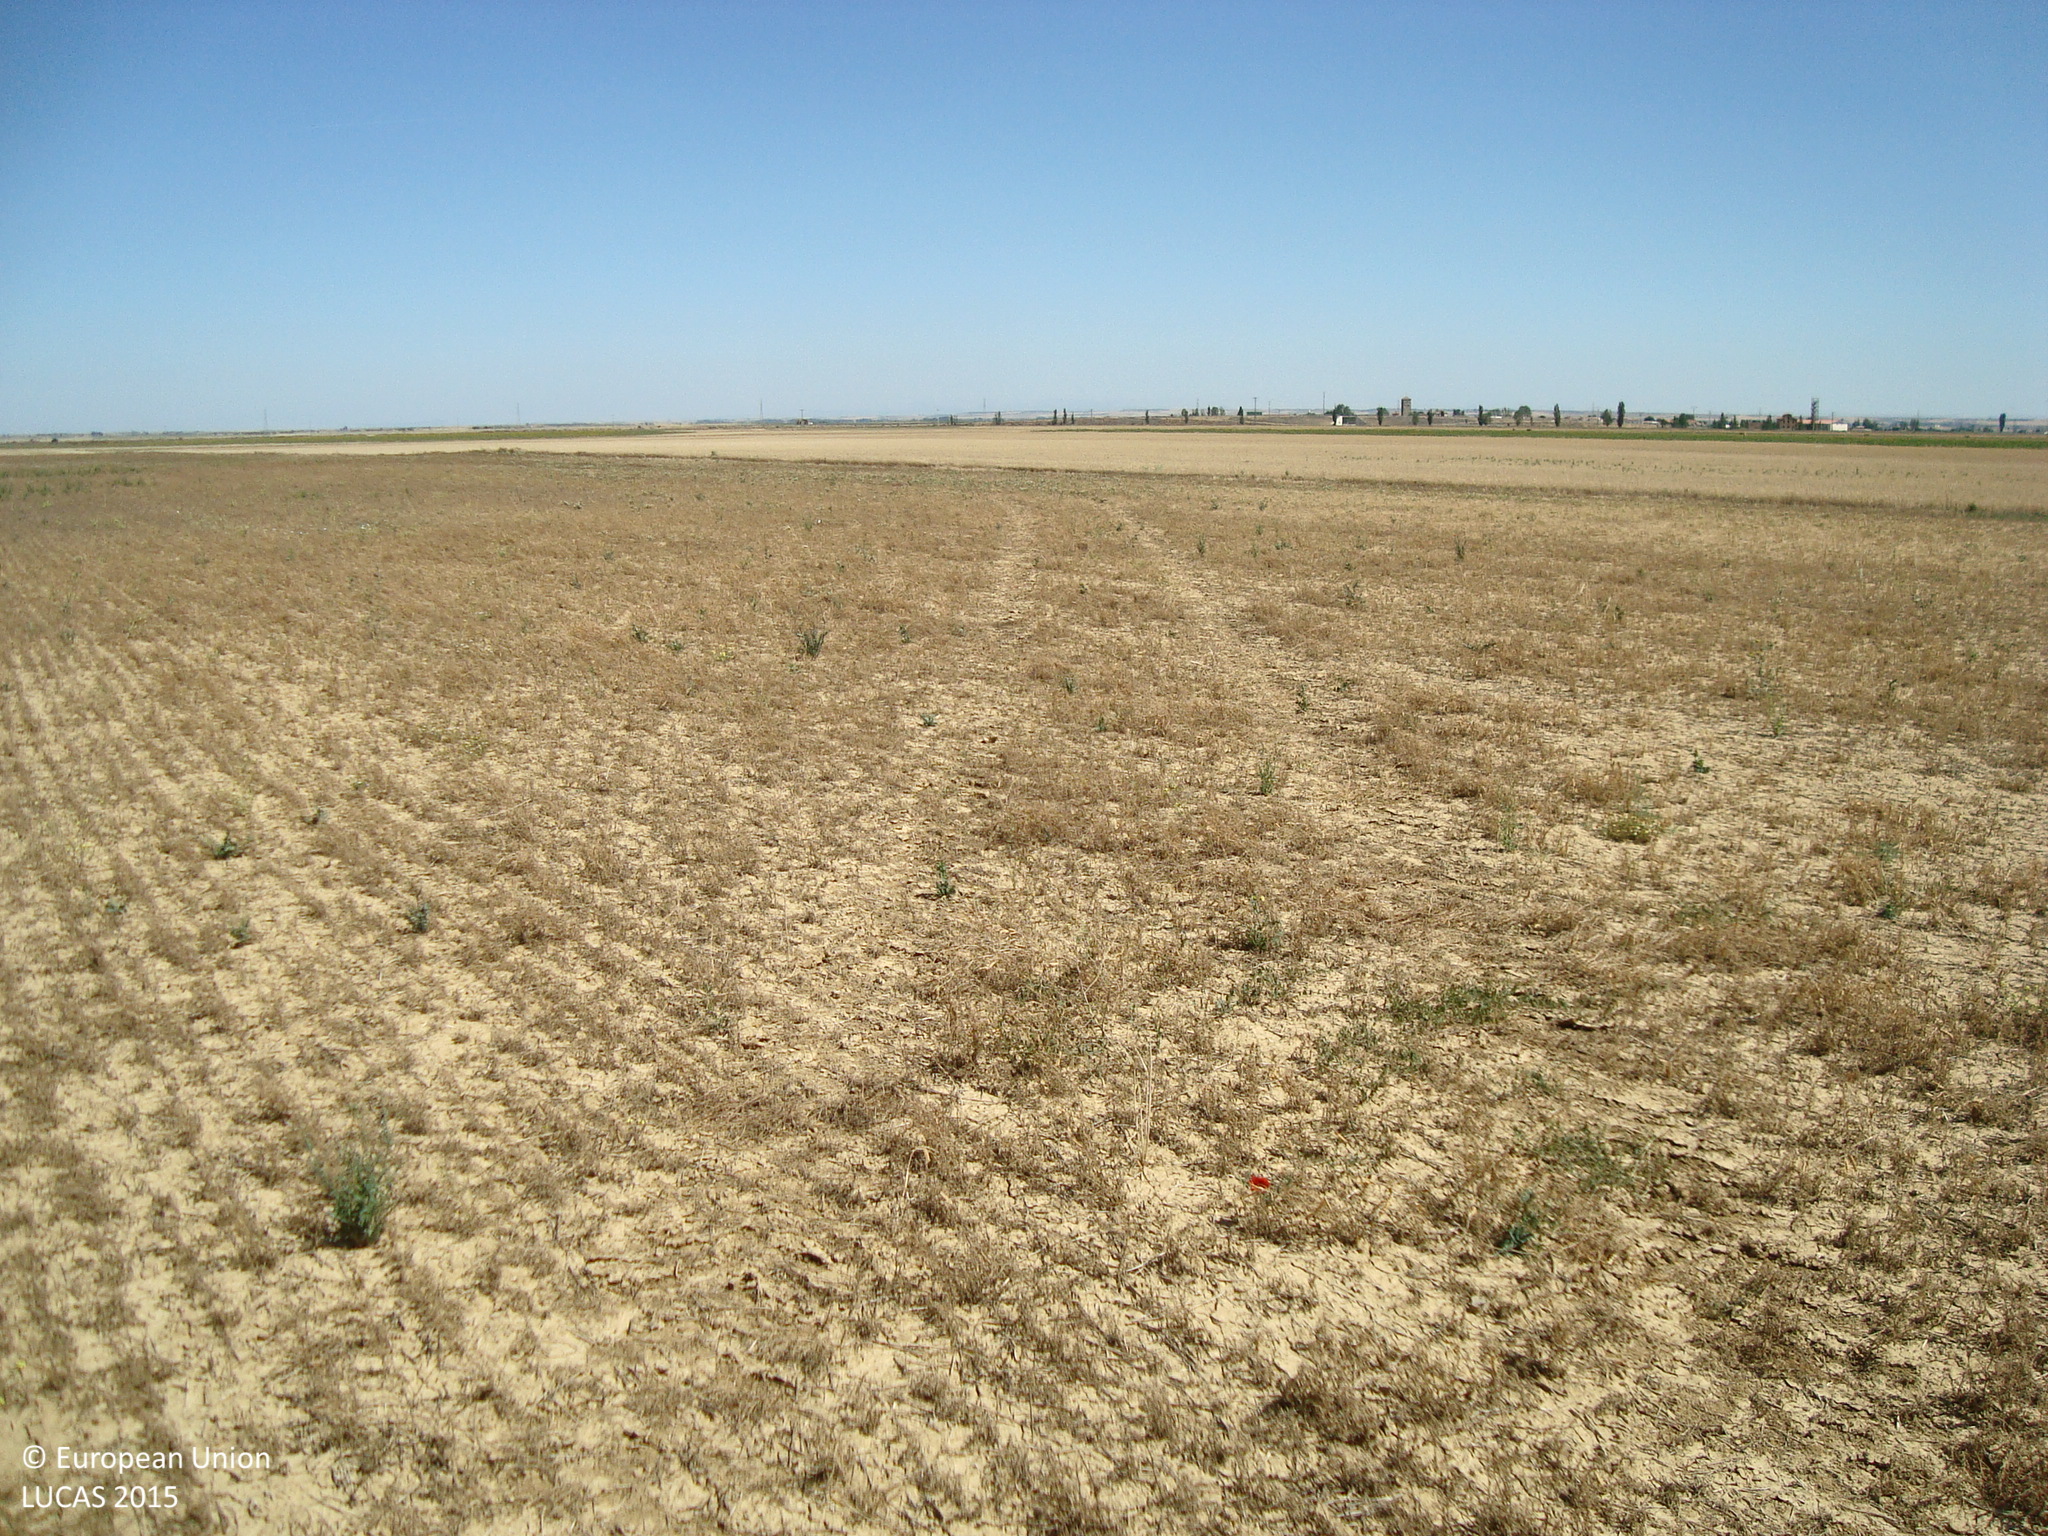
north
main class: Cropland
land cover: Dry pulses
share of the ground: < 10 %
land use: Agriculture (excluding fallow land and kitchen gardens)
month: July
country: ES
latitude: 42.0116
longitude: -4.7205
